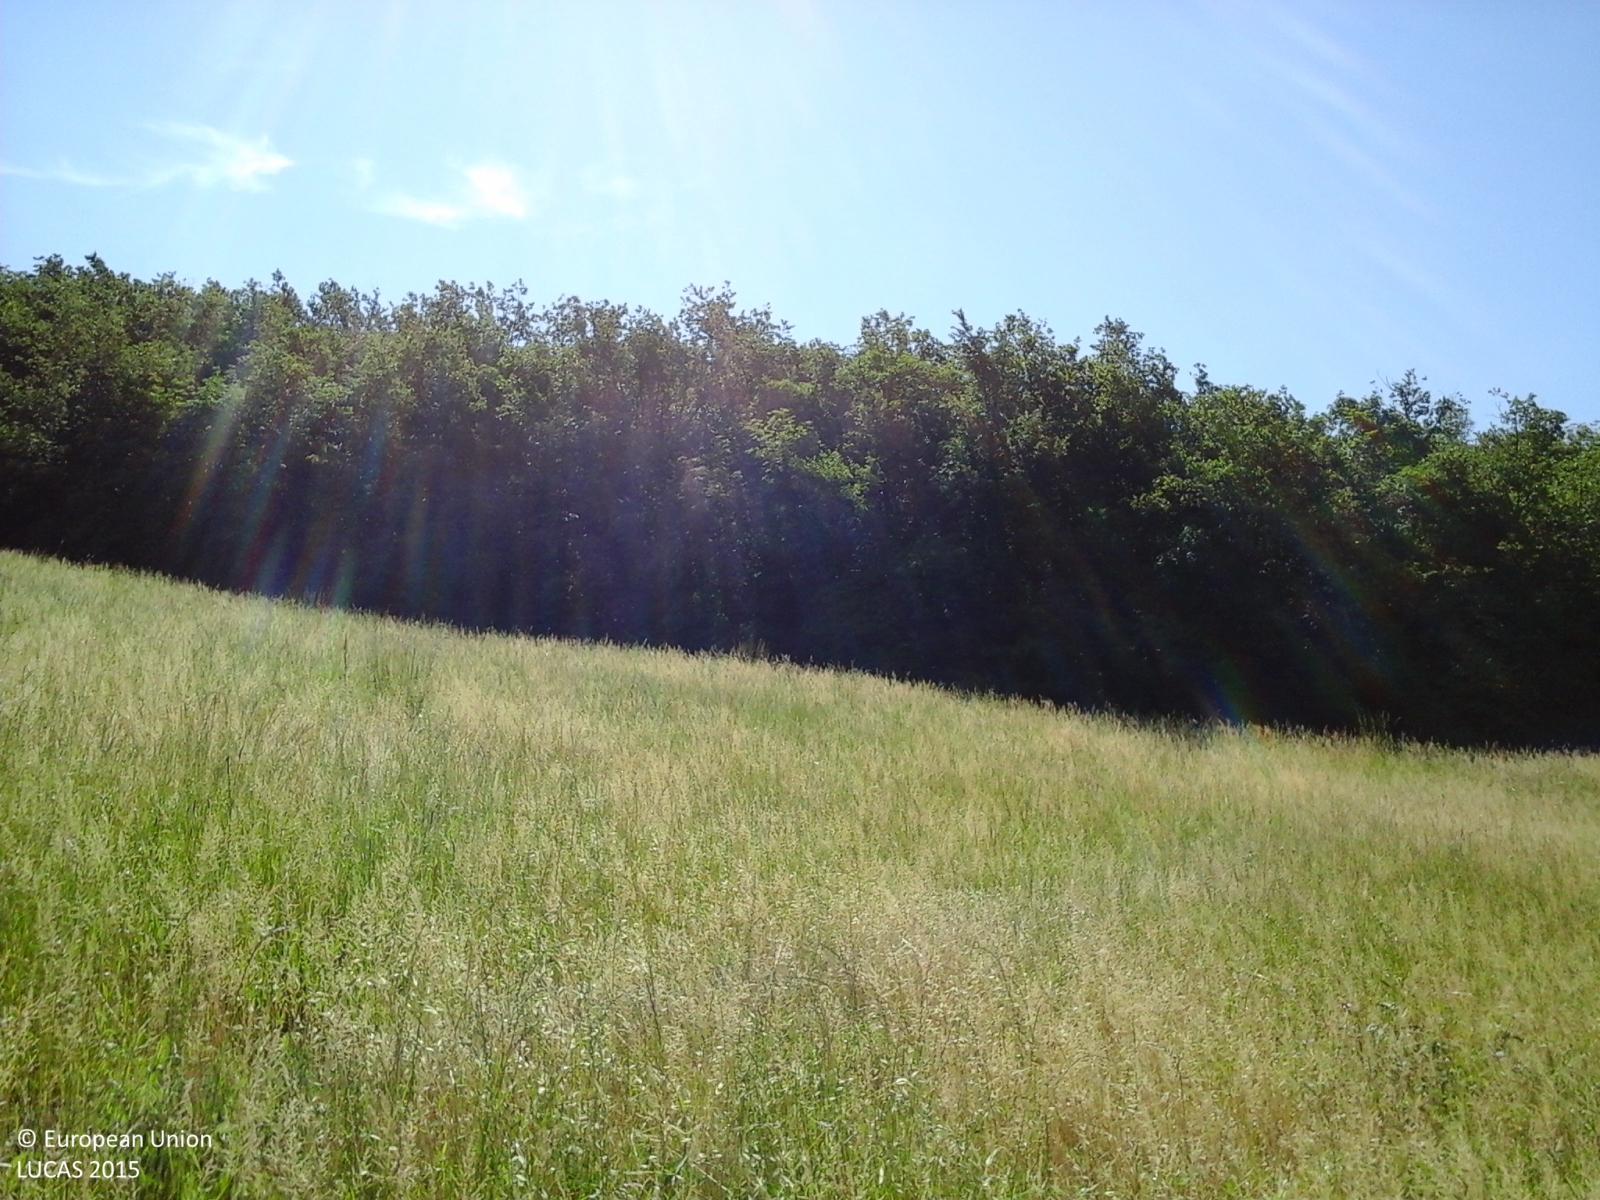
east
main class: Grassland
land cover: Grassland without tree/shrub cover
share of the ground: > 75 %
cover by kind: herbaceous plants 100 %
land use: Agriculture (excluding fallow land and kitchen gardens)
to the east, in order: Grassland without tree/shrub cover; Broadleaved woodland; Tracks; Broadleaved woodland; Rocks and stones
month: May
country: IT
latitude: 44.7293
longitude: 10.0126
